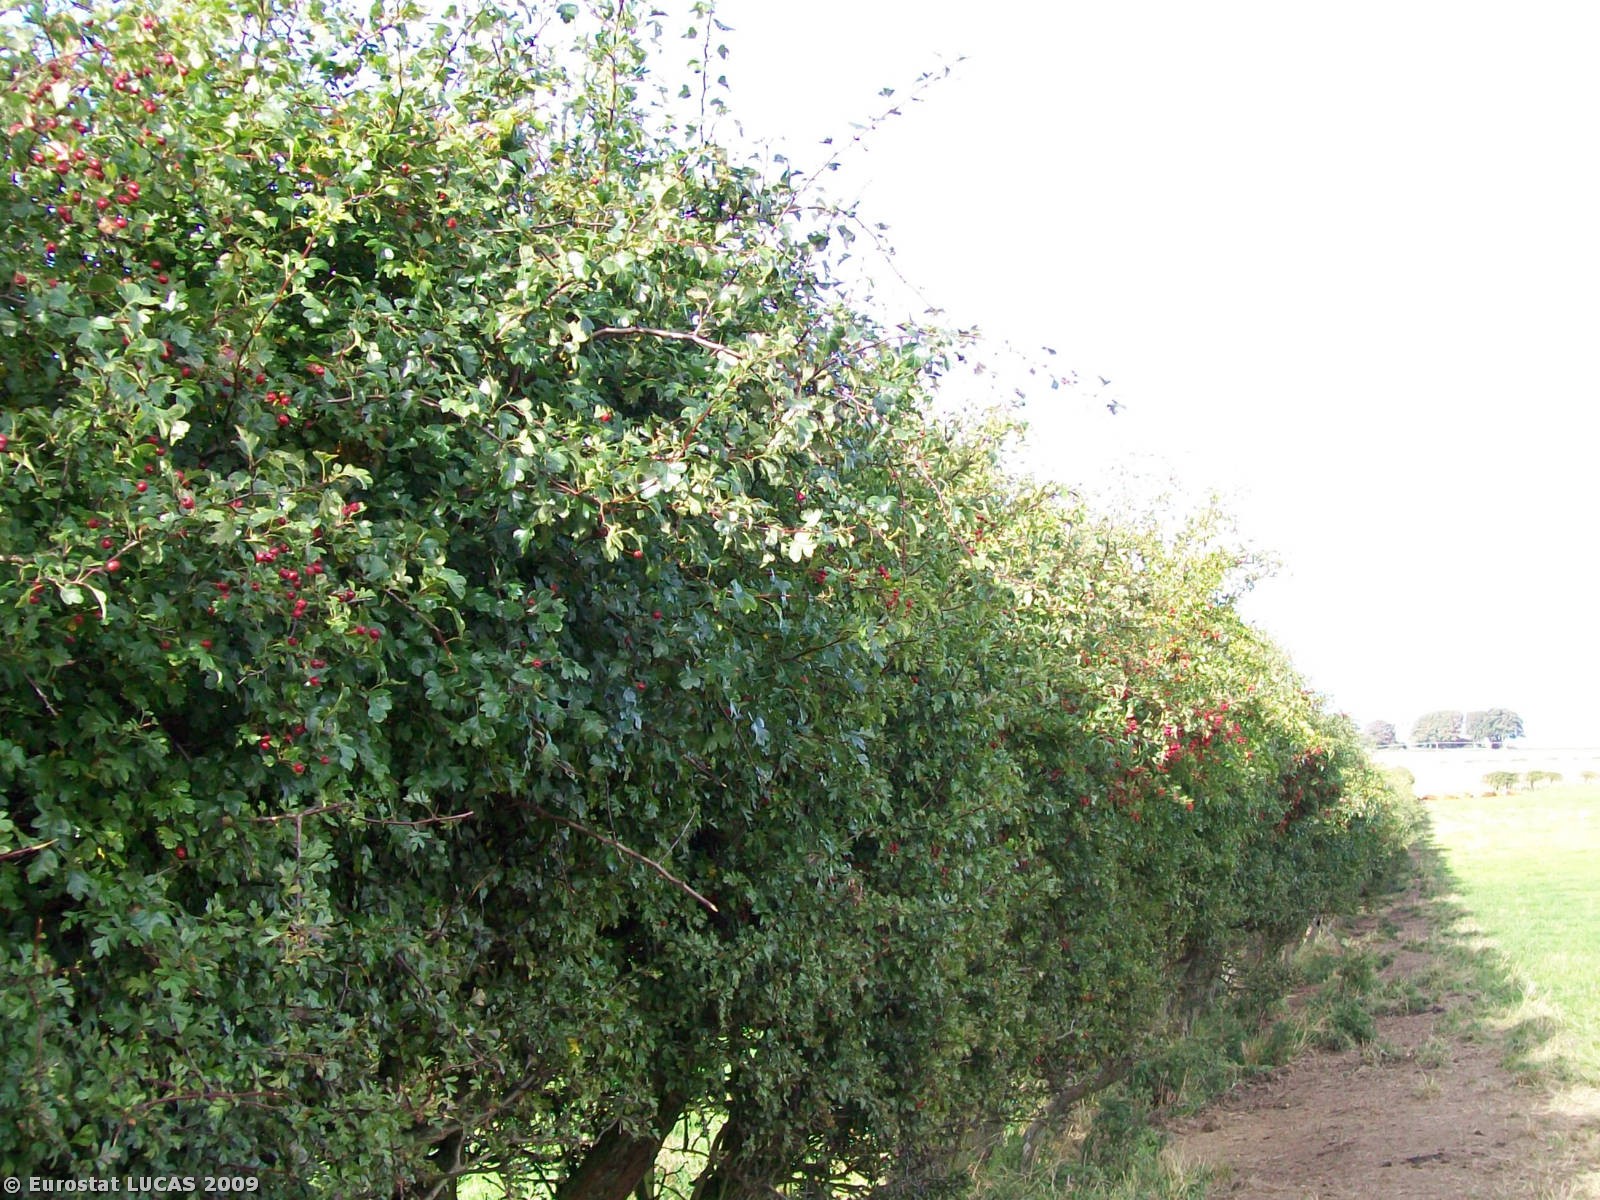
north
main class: Grassland
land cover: Grassland without tree/shrub cover
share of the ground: > 75 %
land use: Agriculture (excluding fallow land and kitchen gardens)
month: September
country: GB
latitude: 55.6478
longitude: -1.9215
